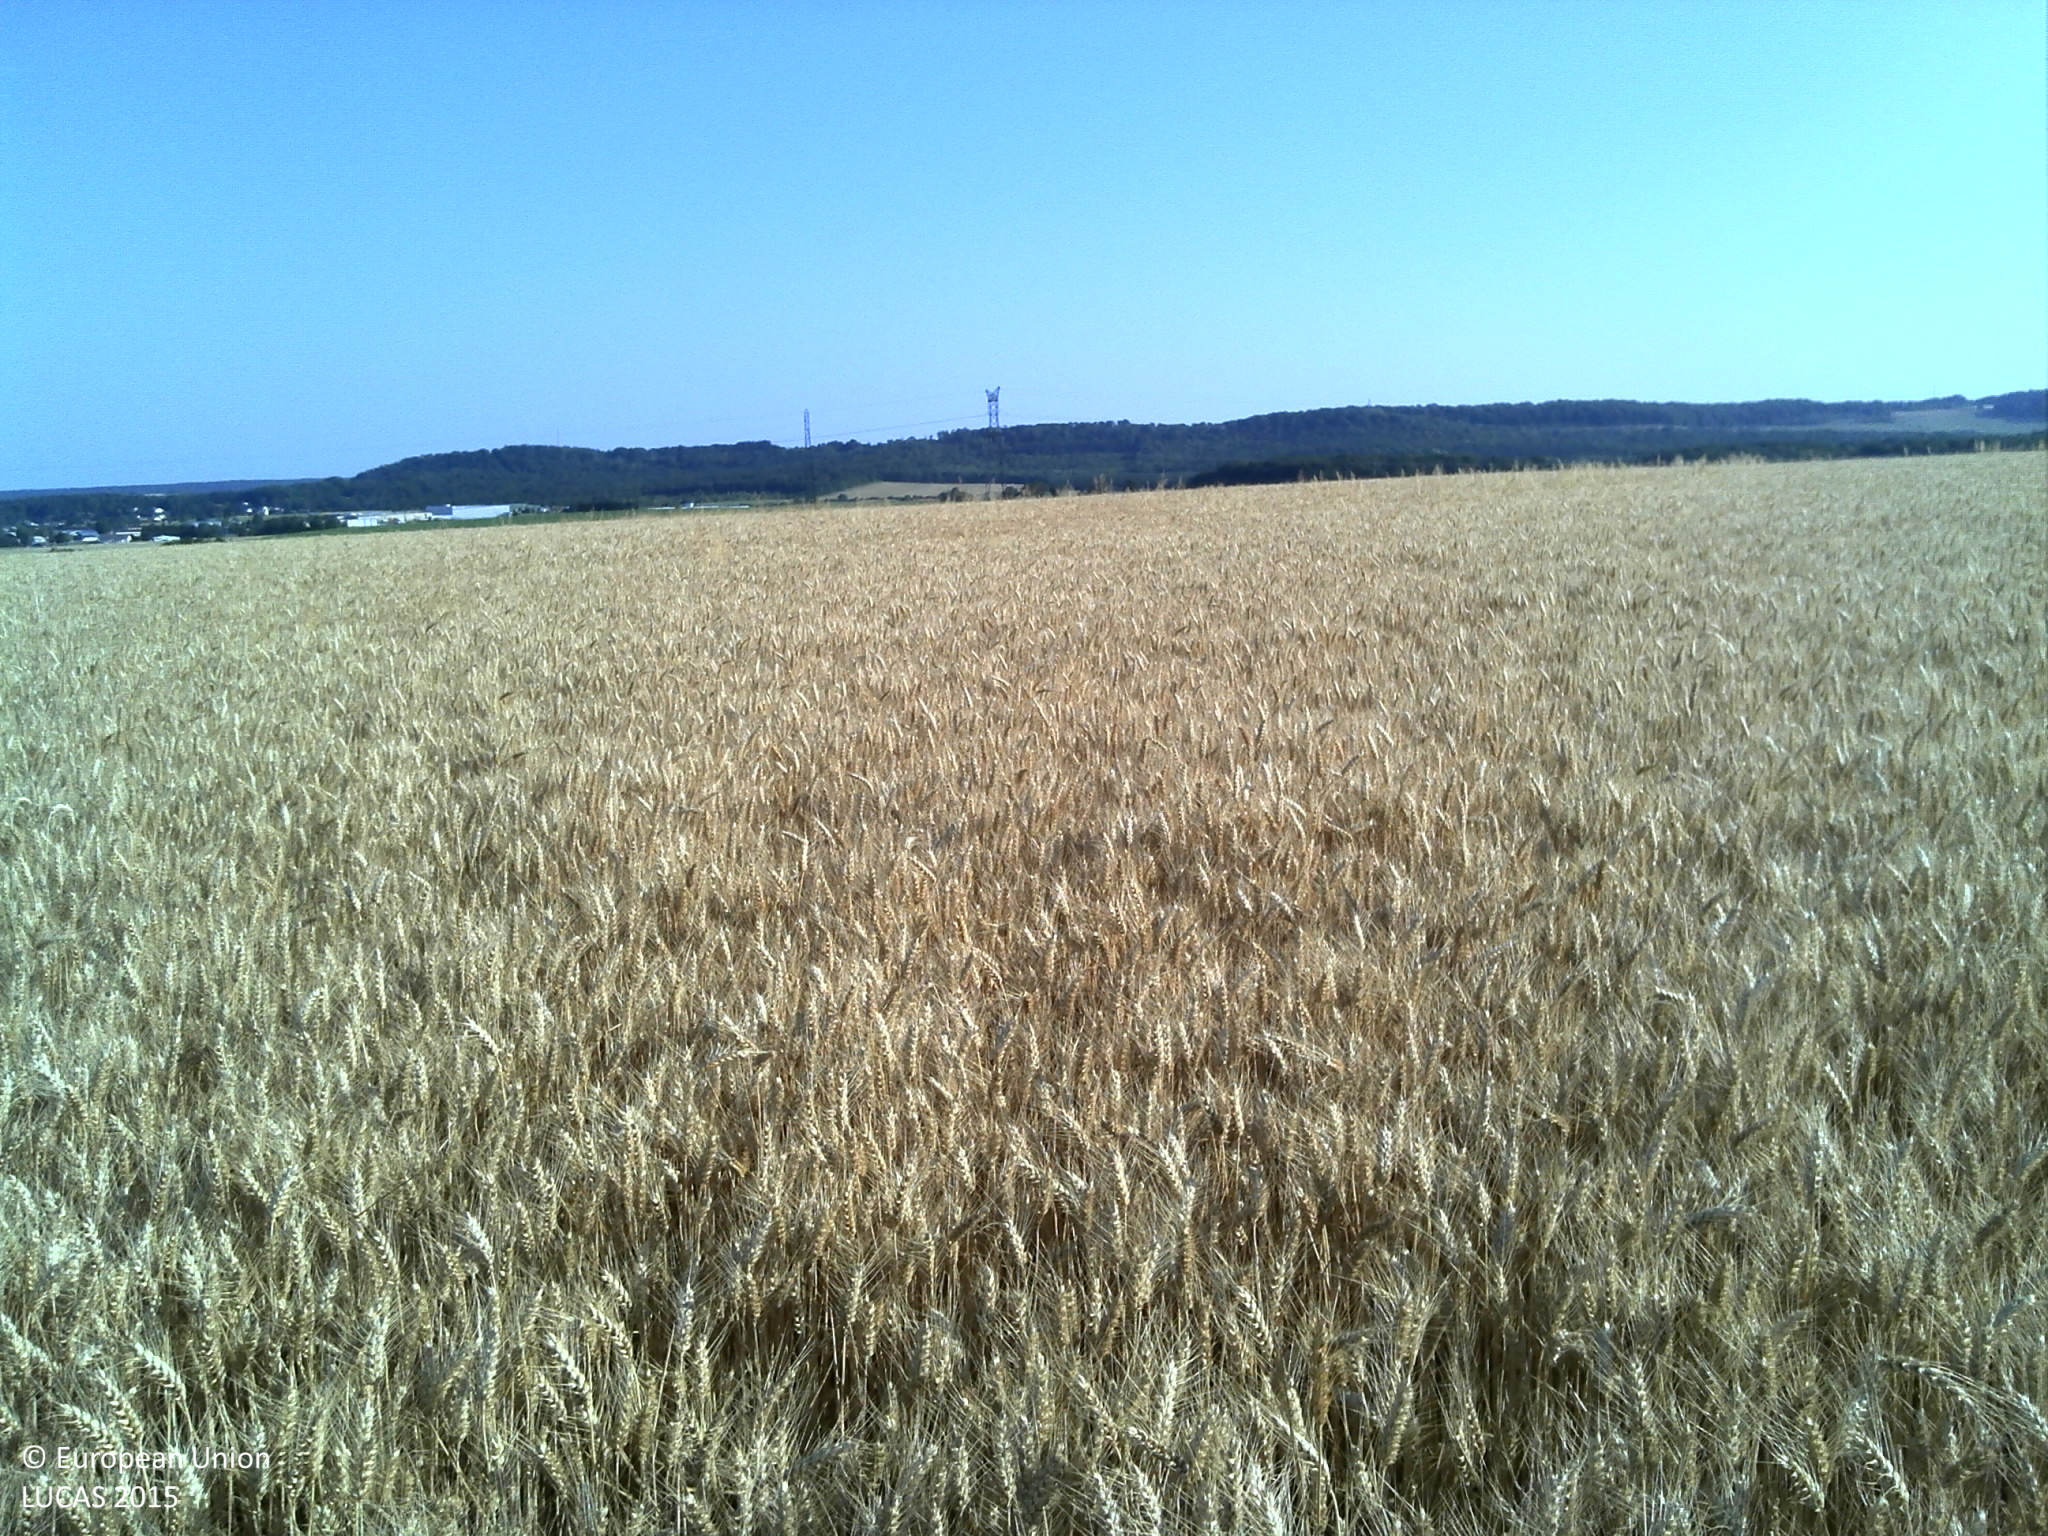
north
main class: Cropland
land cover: Durum wheat
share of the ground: > 75 %
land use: Agriculture (excluding fallow land and kitchen gardens)
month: July
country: FR
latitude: 48.1863
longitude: 5.9785
